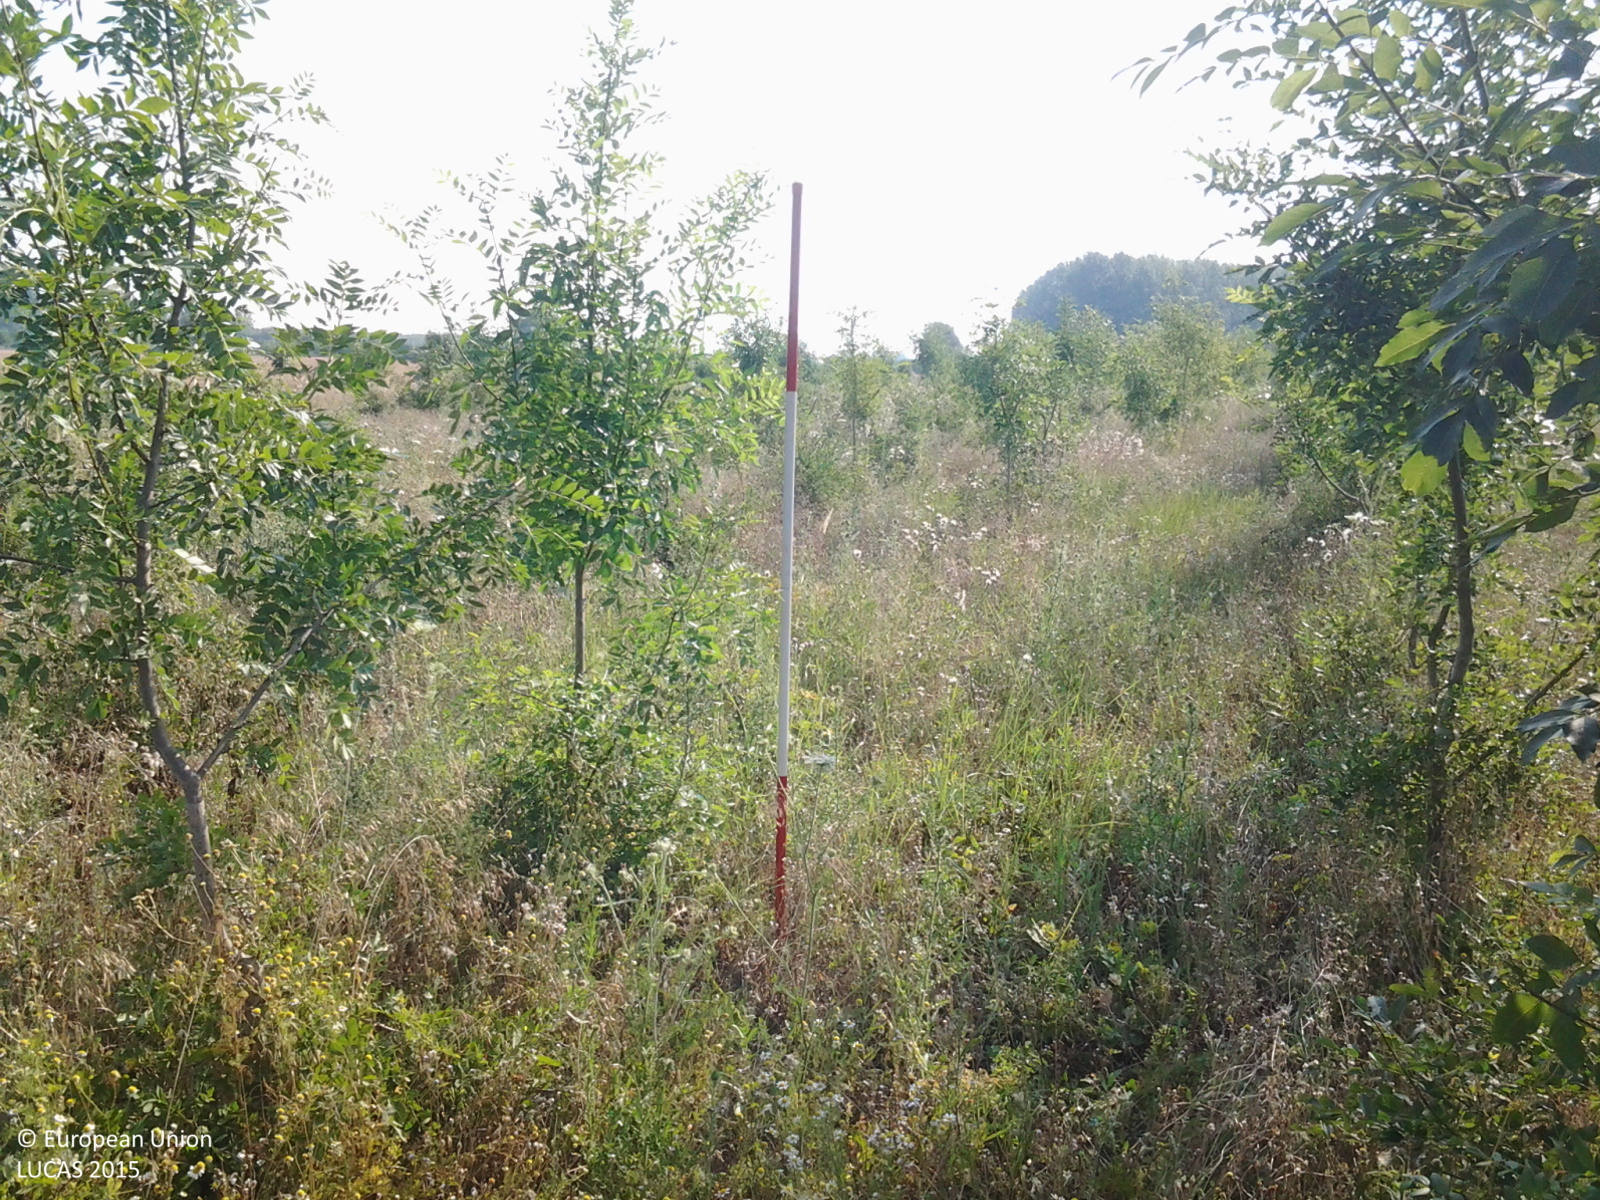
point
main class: Woodland
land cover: Broadleaved woodland
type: mesophytic deciduous forest
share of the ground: > 75 %
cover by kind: broadleaved forest trees 75 %, herbaceous plants 20 %, shrubs 5 %
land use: Forestry
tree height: < 5 m
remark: Nursery
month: July
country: HU
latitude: 46.7561
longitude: 21.4148
